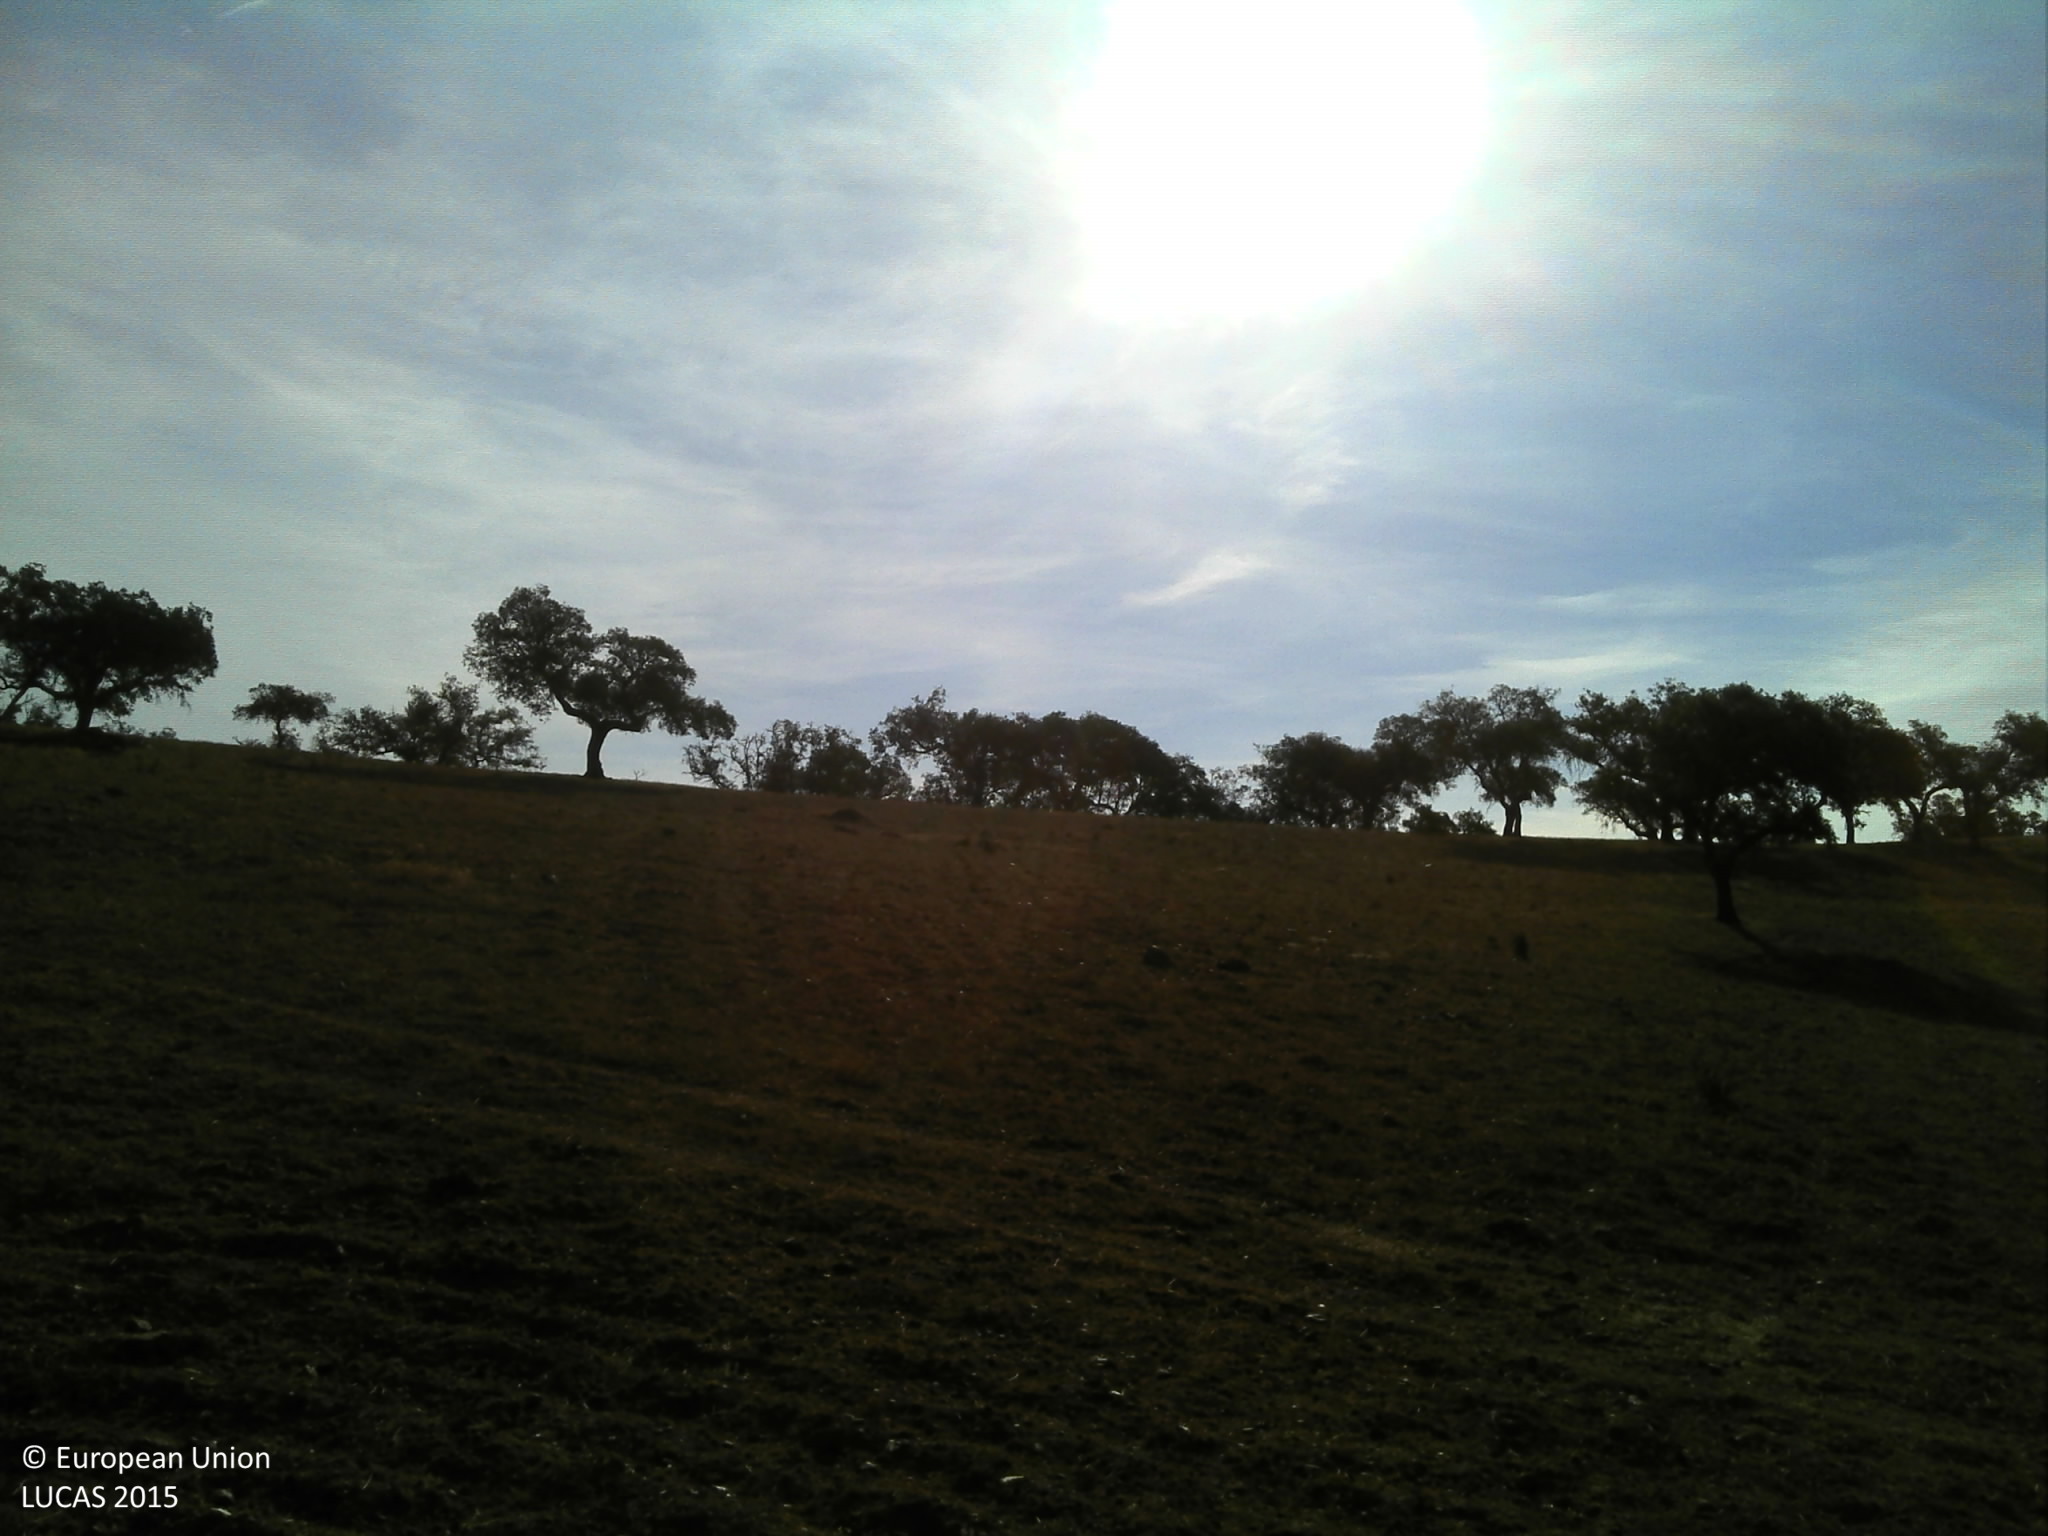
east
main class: Woodland
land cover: Broadleaved woodland
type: broadleaved evergreen forest
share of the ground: 10 - 25 %
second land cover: Grassland without tree/shrub cover
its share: 10 - 25 %
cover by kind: unconsolidated bare surface 80 %, broadleaved forest trees 10 %, herbaceous plants 10 %
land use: Forestry
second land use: Agriculture (excluding fallow land and kitchen gardens)
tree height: > 5 m
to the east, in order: Broadleaved woodland; Grassland without tree/shrub cover; Single bushes/trees; Grassland without tree/shrub cover; Broadleaved woodland; Tracks; Broadleaved woodland; Grassland without tree/shrub cover; Broadleaved woodland
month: July
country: PT
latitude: 38.3236
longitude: -7.6321
